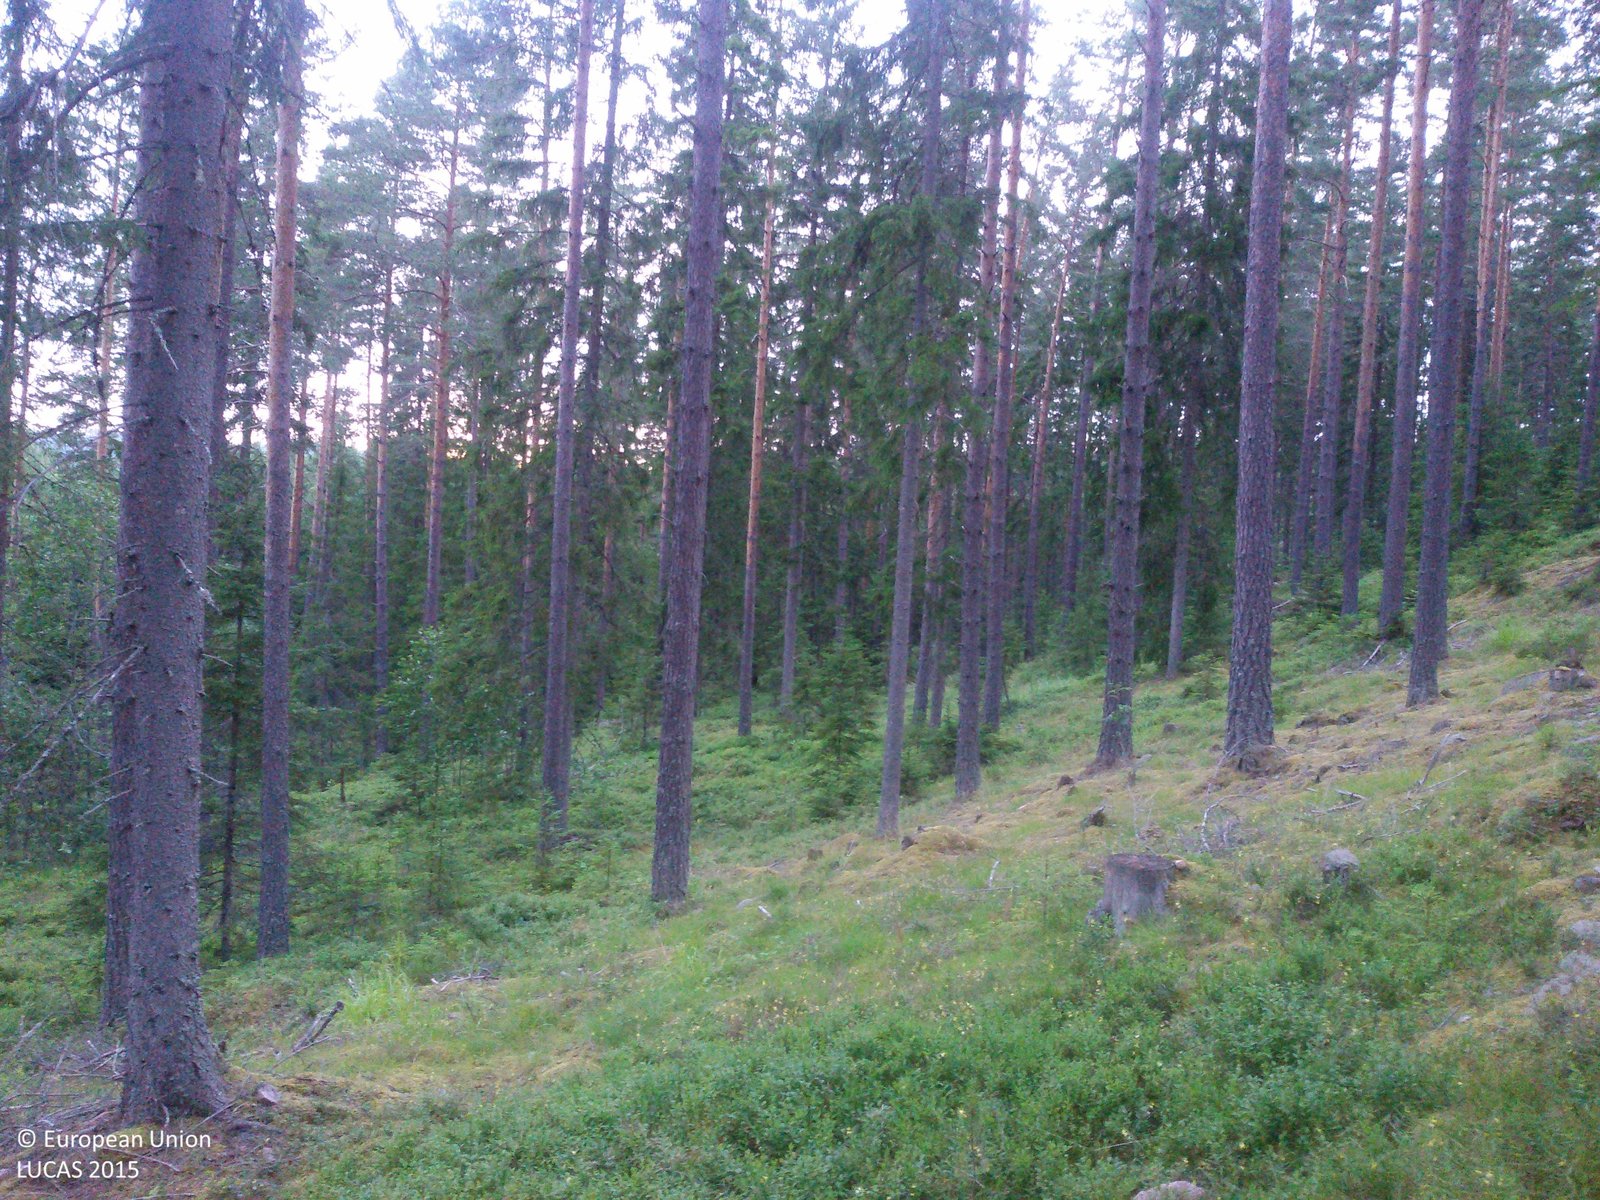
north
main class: Woodland
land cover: Pine dominated coniferous woodland
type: boreal forest
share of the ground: 50 - 75 %
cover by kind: coniferous forest trees 50 %, shrubs 25 %, lichens and mosses 20 %, herbaceous plants 5 %
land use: Forestry
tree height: > 5 m
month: July
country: SE
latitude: 60.4609
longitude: 15.2793
